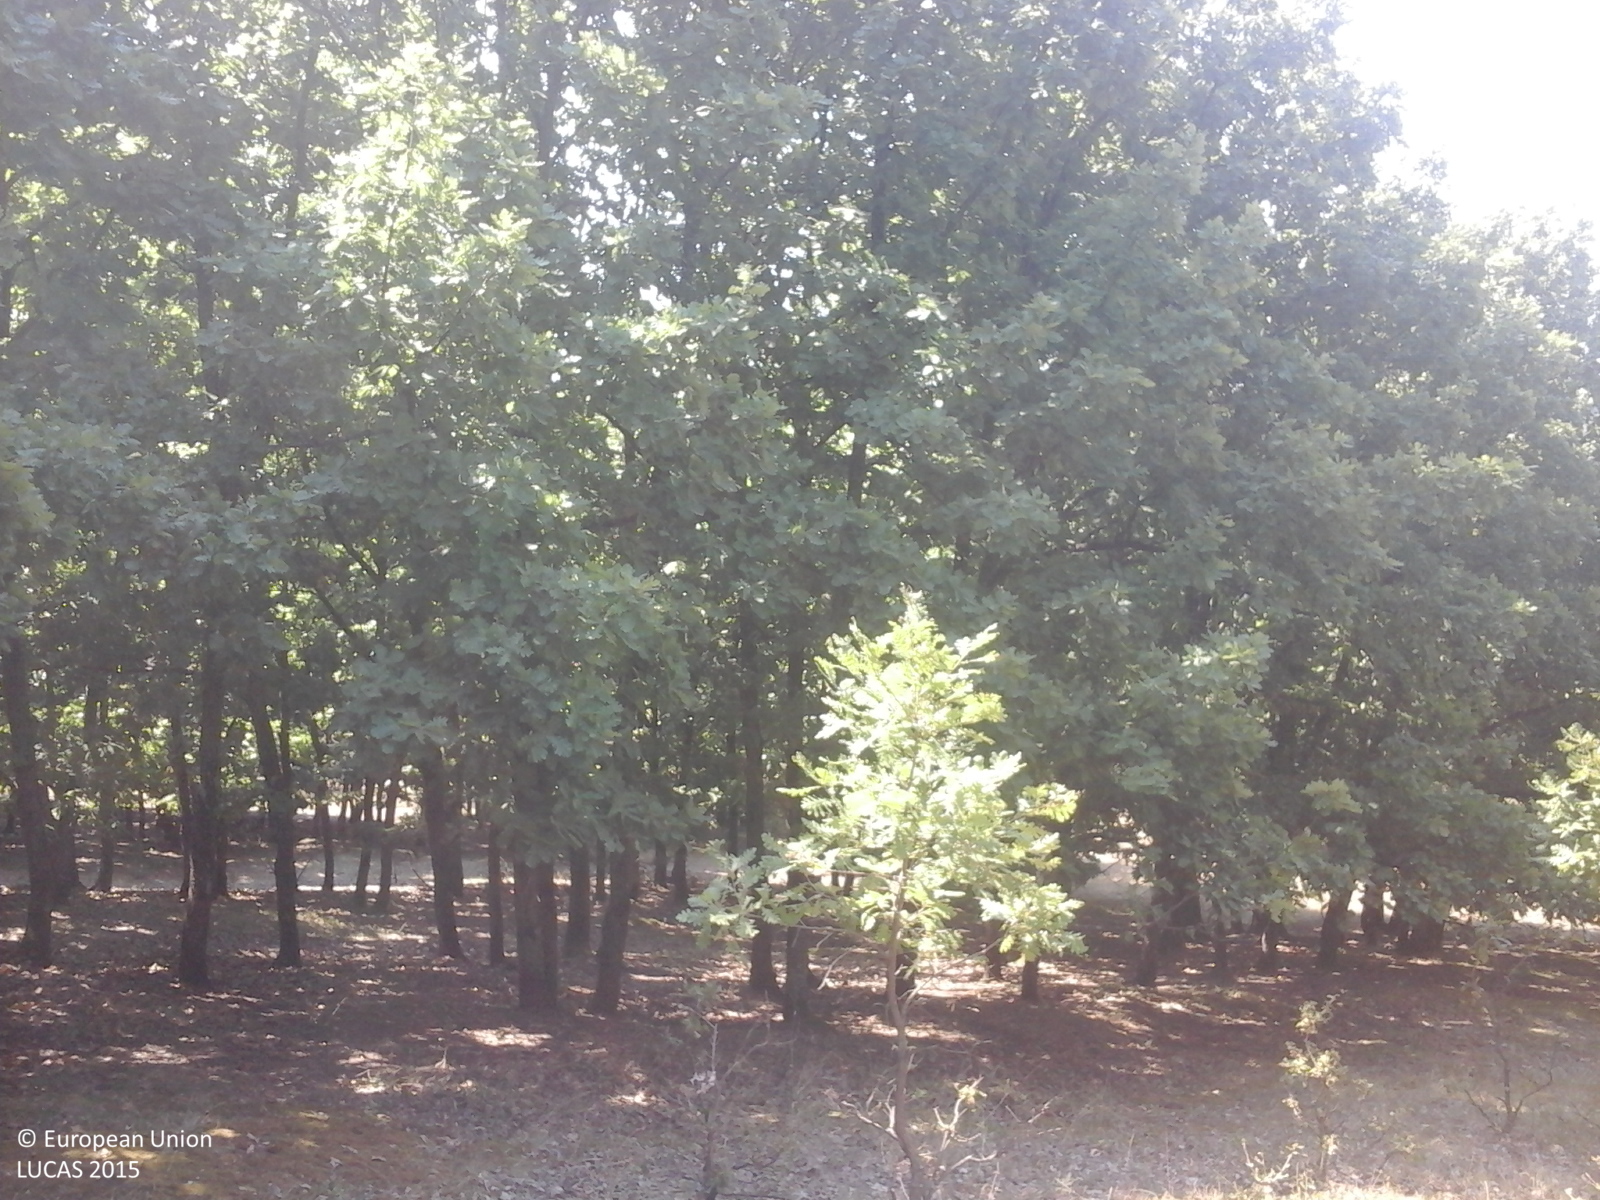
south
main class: Woodland
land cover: Broadleaved woodland
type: acidophilous oak and oak-birch forest
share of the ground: > 75 %
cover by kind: broadleaved forest trees 100 %
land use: Forestry
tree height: > 5 m
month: August
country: RO
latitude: 44.5207
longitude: 23.6566
